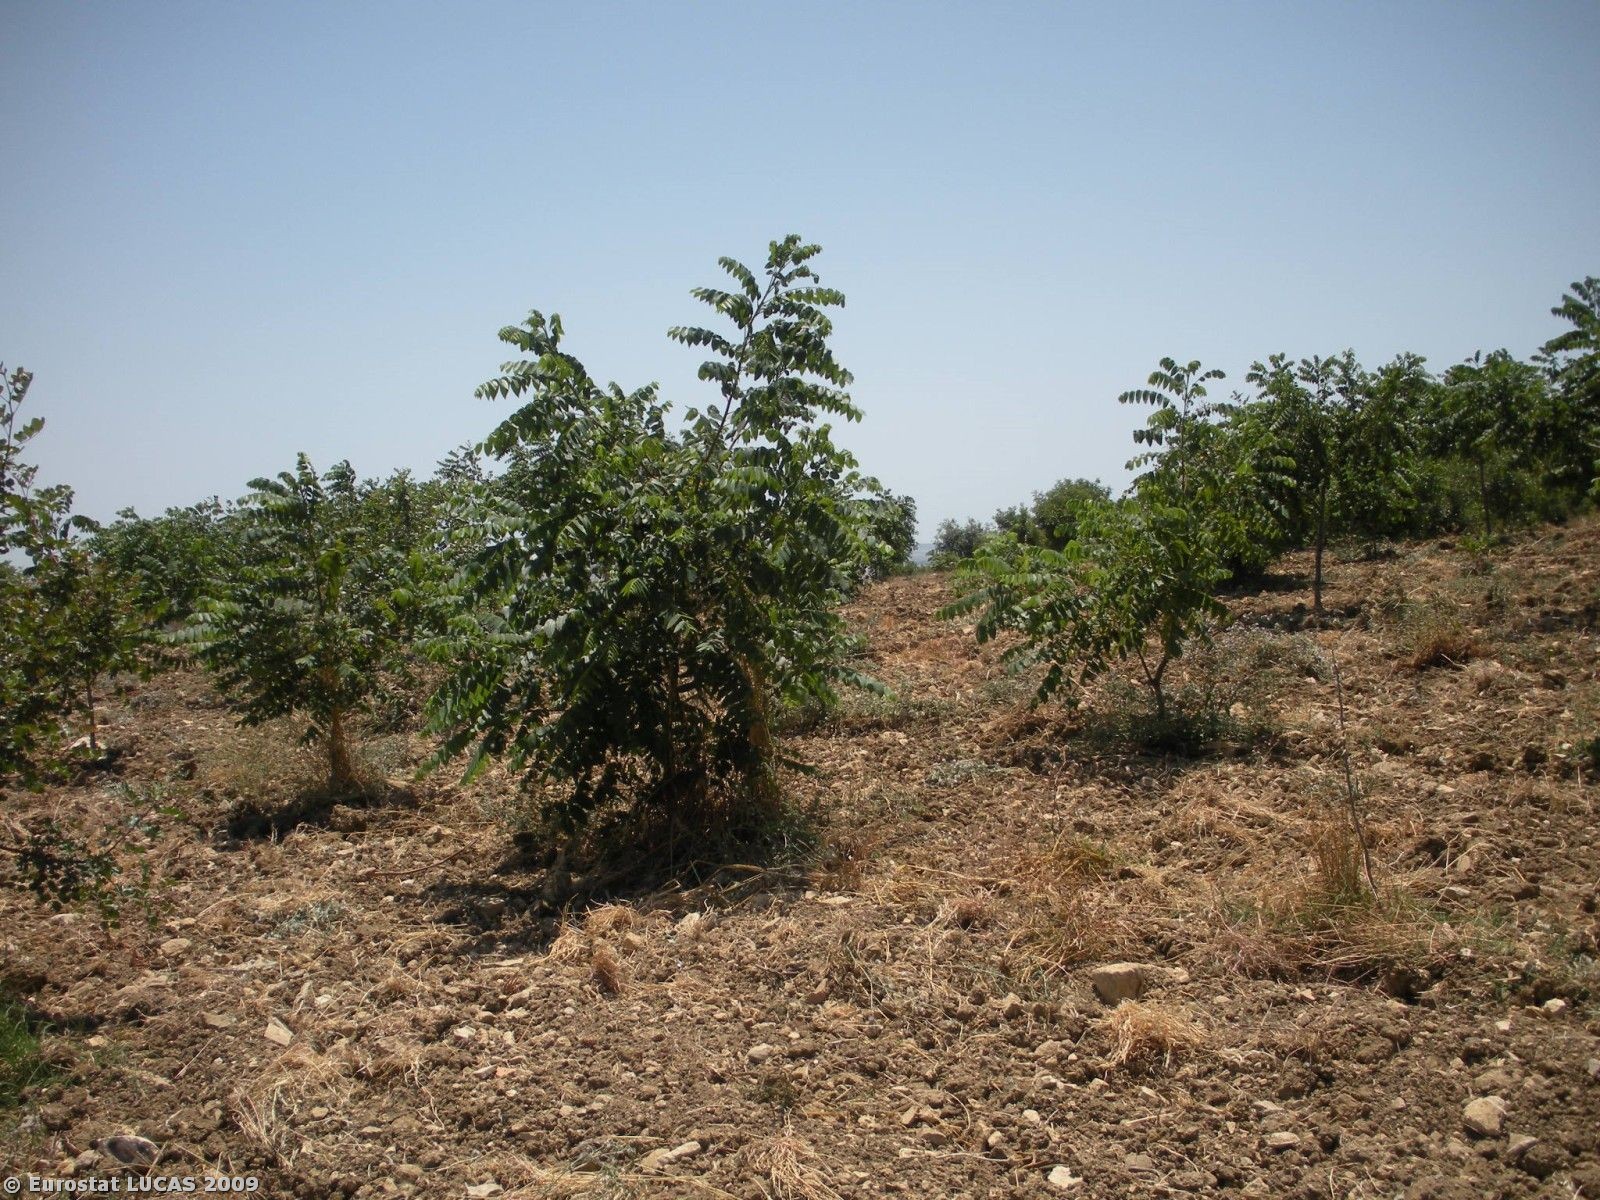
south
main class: Cropland
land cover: Nuts trees
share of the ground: 25 - 50 %
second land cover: Bare land
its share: > 75 %
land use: Agriculture (excluding fallow land and kitchen gardens)
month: July
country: IT
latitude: 38.0379
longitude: 12.6358
